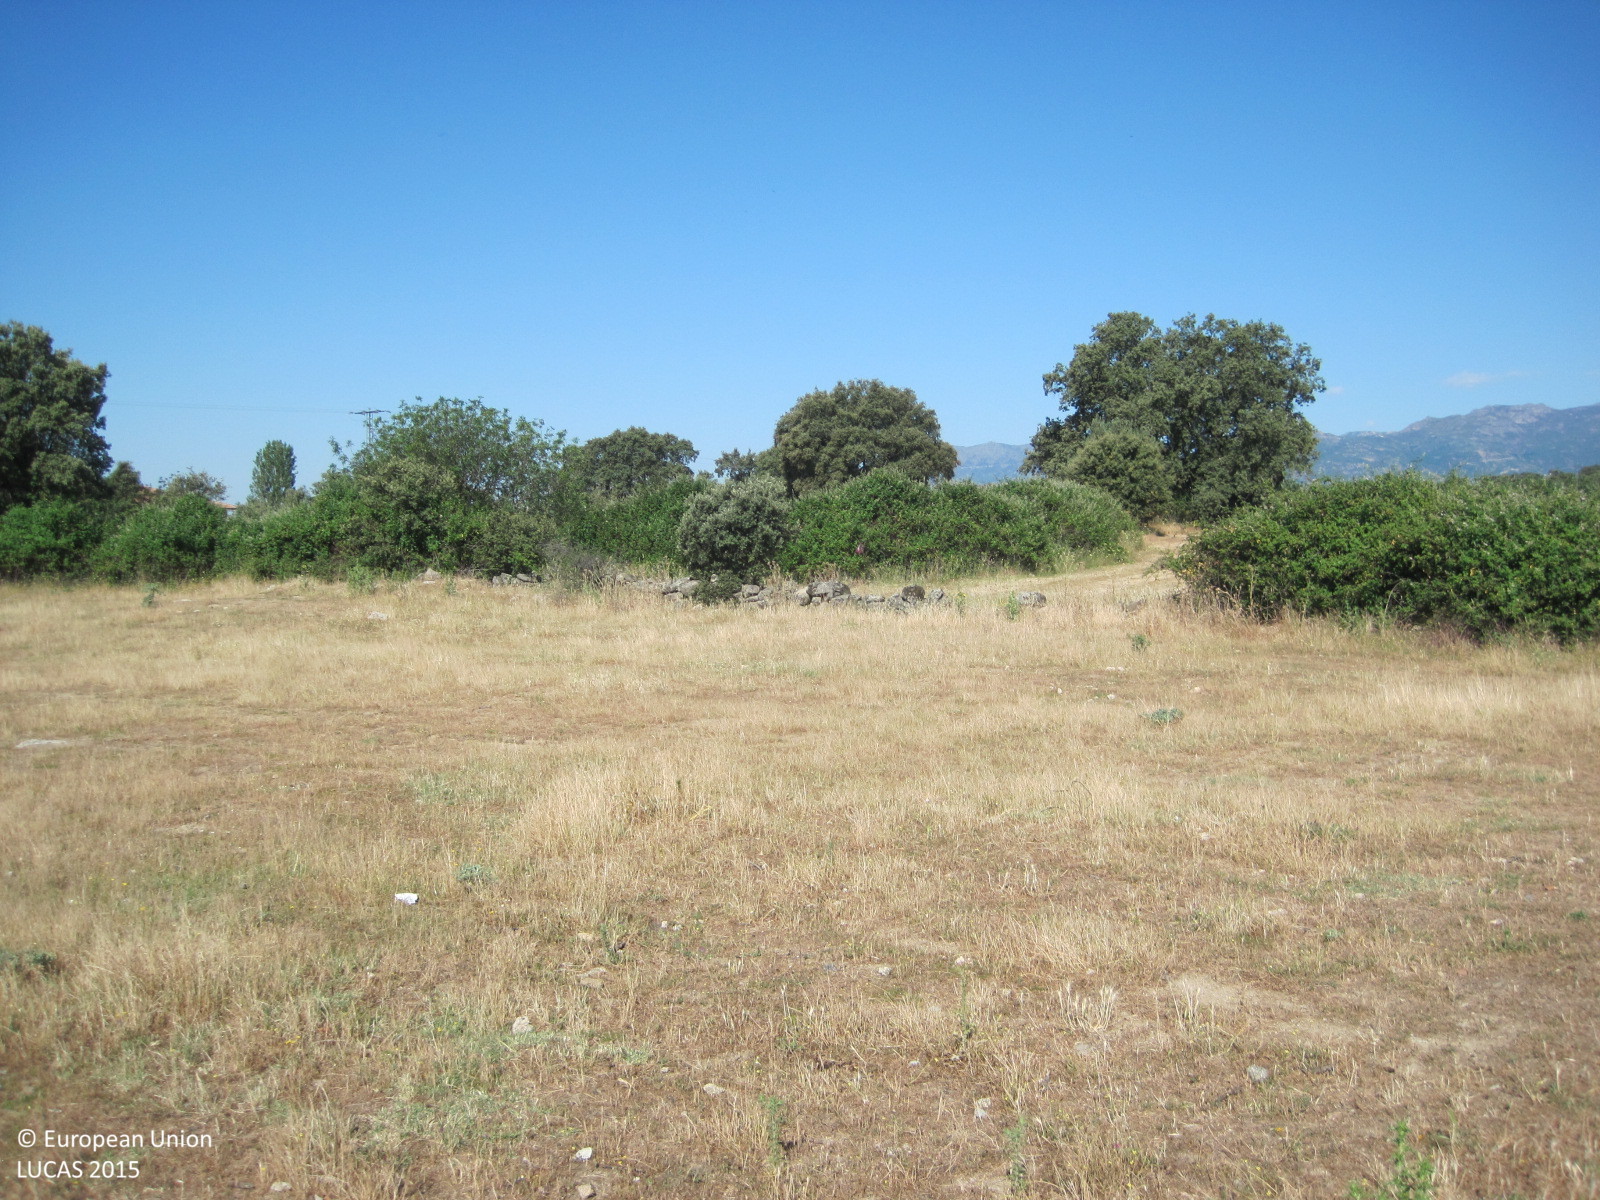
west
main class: Grassland
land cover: Grassland without tree/shrub cover
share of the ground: > 75 %
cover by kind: herbaceous plants 100 %
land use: Agriculture (excluding fallow land and kitchen gardens)
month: May
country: ES
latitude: 40.2281
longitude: -4.7527
